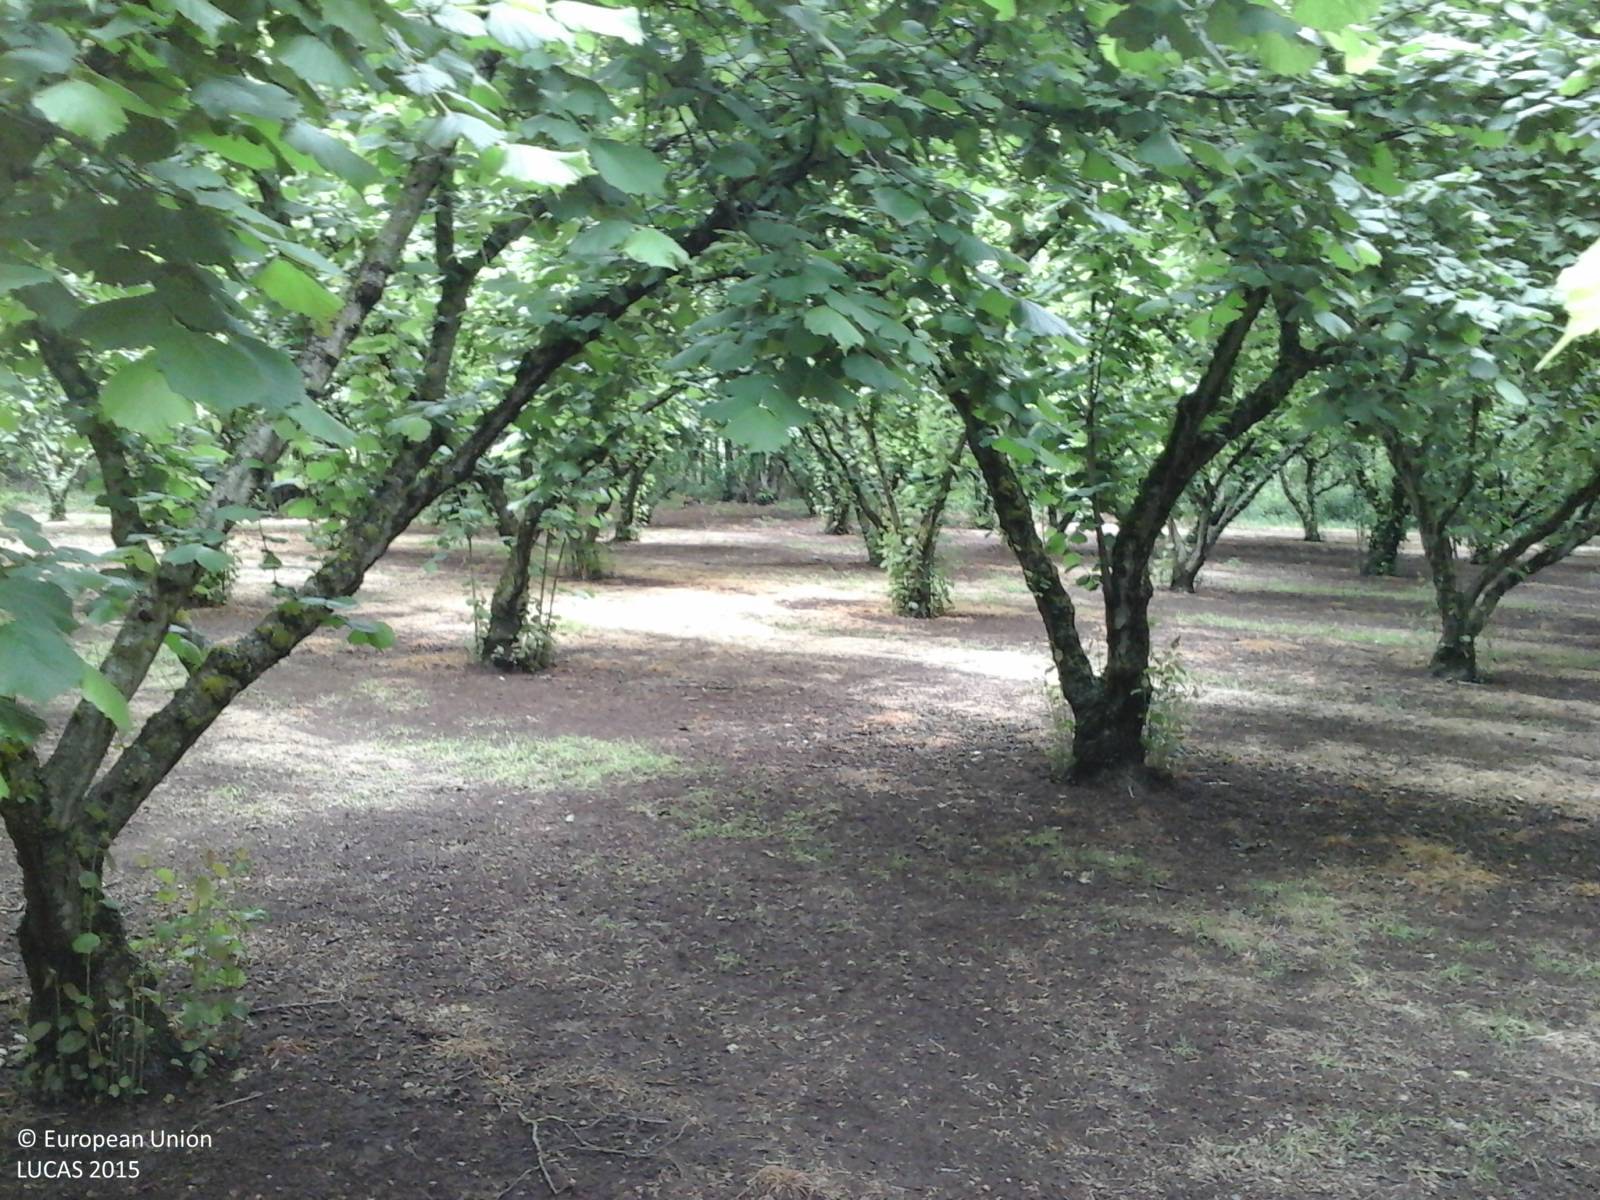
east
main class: Cropland
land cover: Nuts trees
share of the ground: > 75 %
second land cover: Other bare soil
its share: > 75 %
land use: Agriculture (excluding fallow land and kitchen gardens)
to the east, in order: Nuts trees; Other bare soil; Fences; Broadleaved woodland
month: May
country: IT
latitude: 42.2876
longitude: 12.1633
